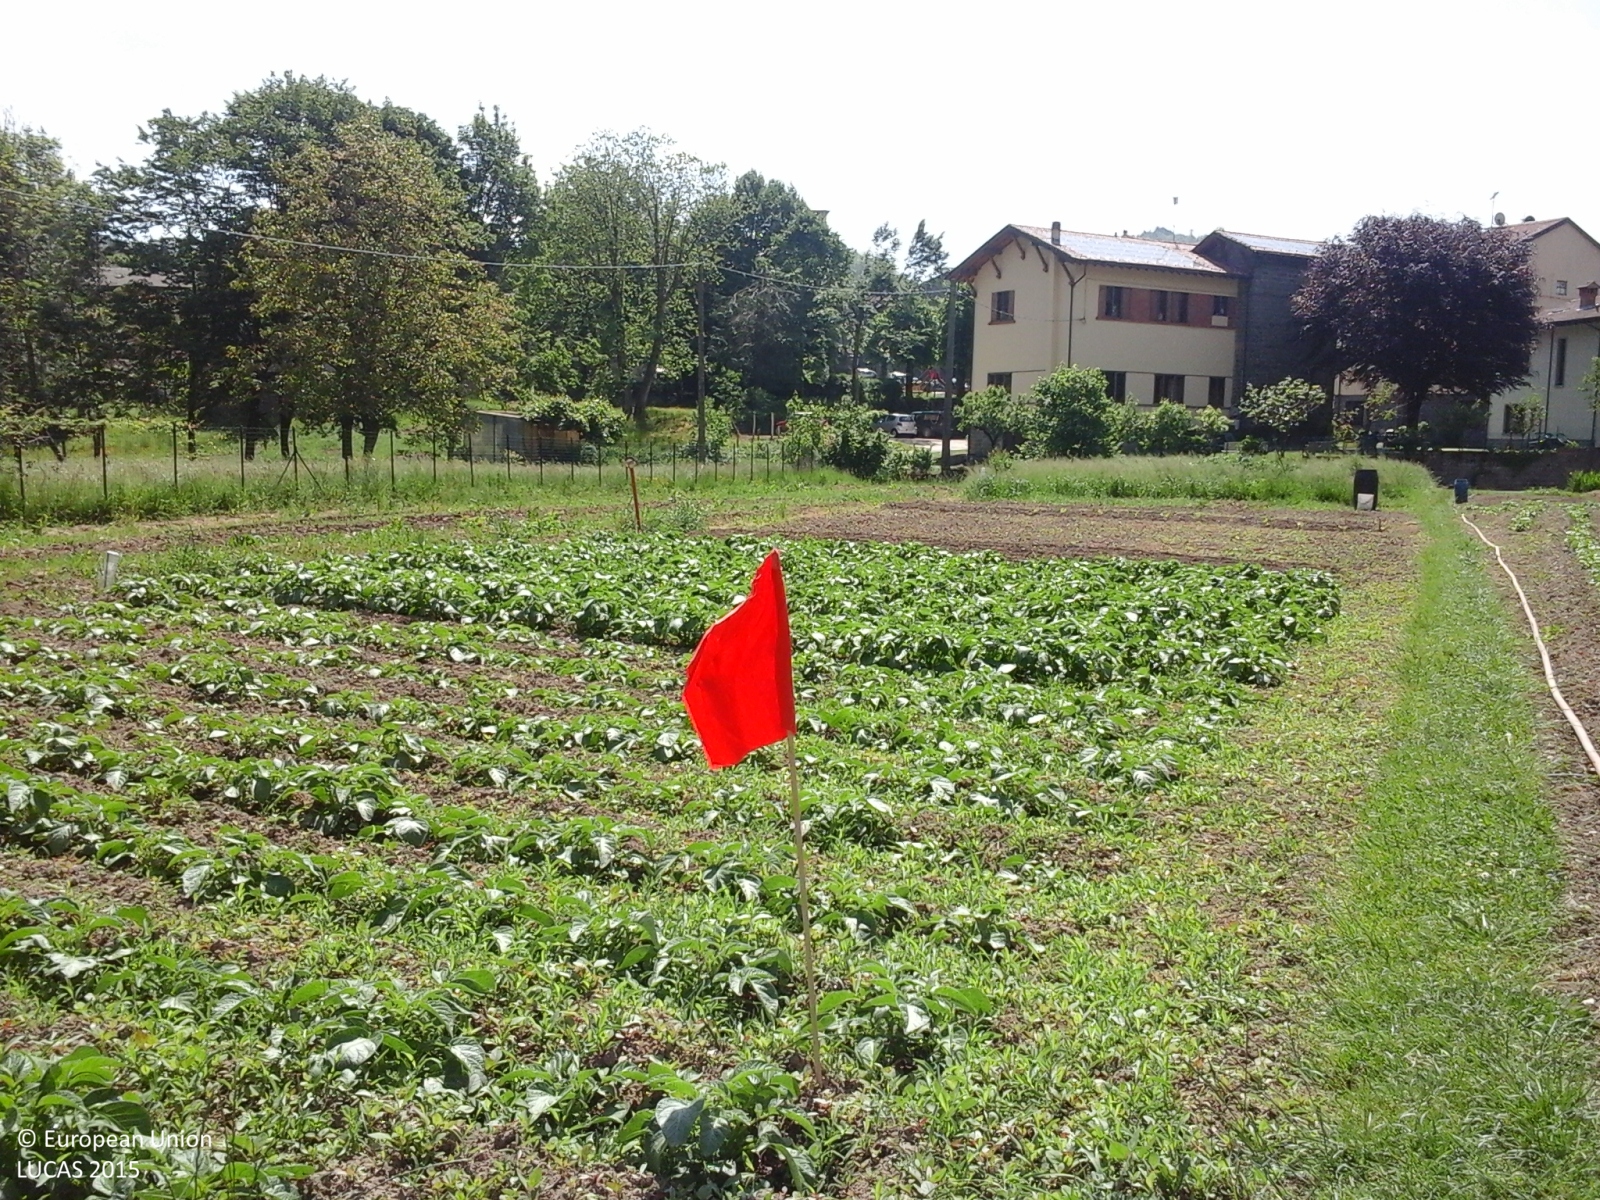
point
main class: Cropland
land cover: Other fresh vegetables
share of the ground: > 75 %
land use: Agriculture (excluding fallow land and kitchen gardens)
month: May
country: IT
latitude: 44.0915
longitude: 11.1588
